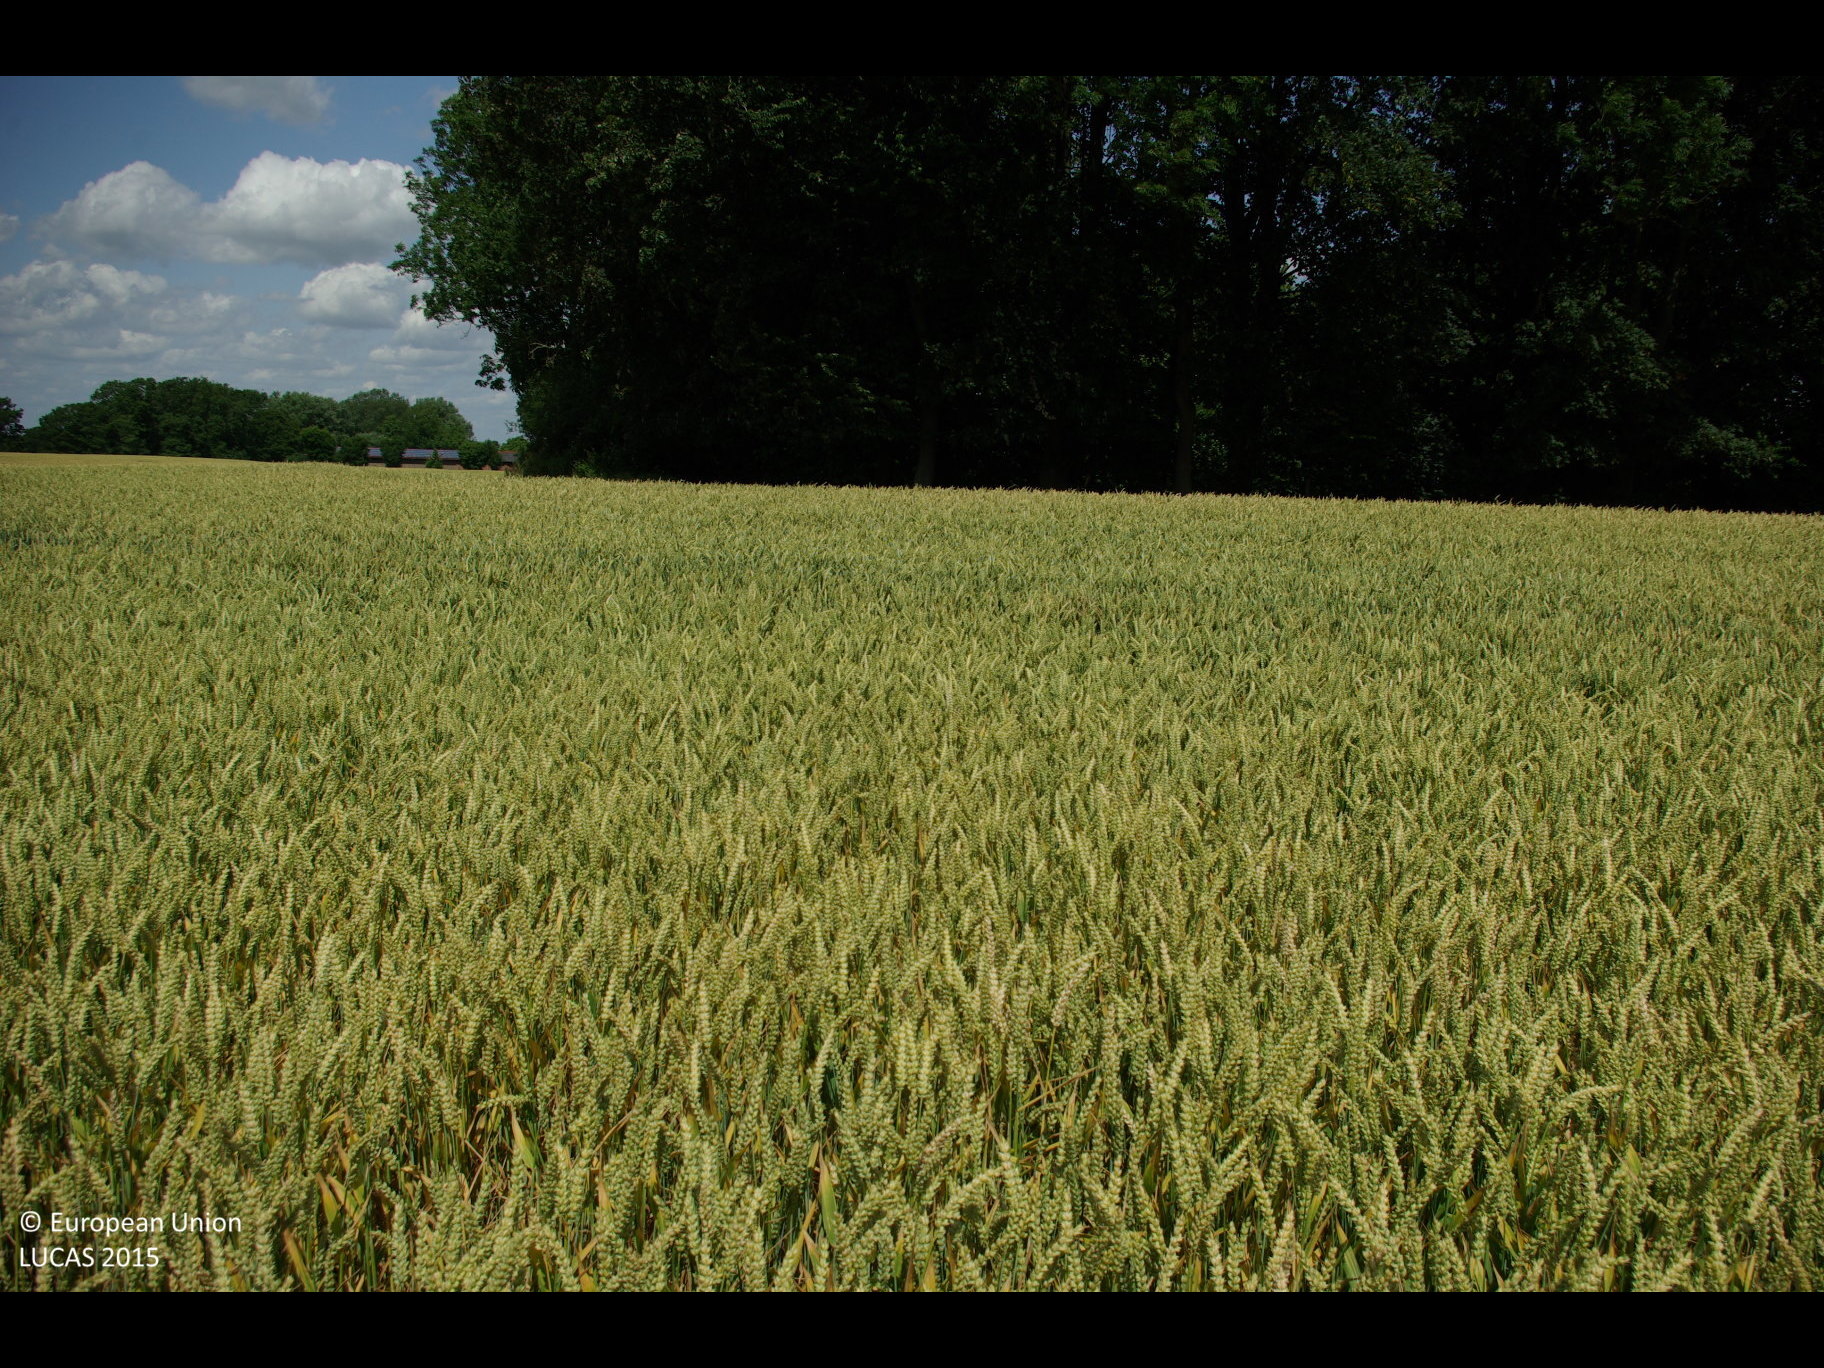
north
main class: Cropland
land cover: Common wheat
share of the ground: > 75 %
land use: Agriculture (excluding fallow land and kitchen gardens)
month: July
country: DE
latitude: 54.5341
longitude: 9.9537
